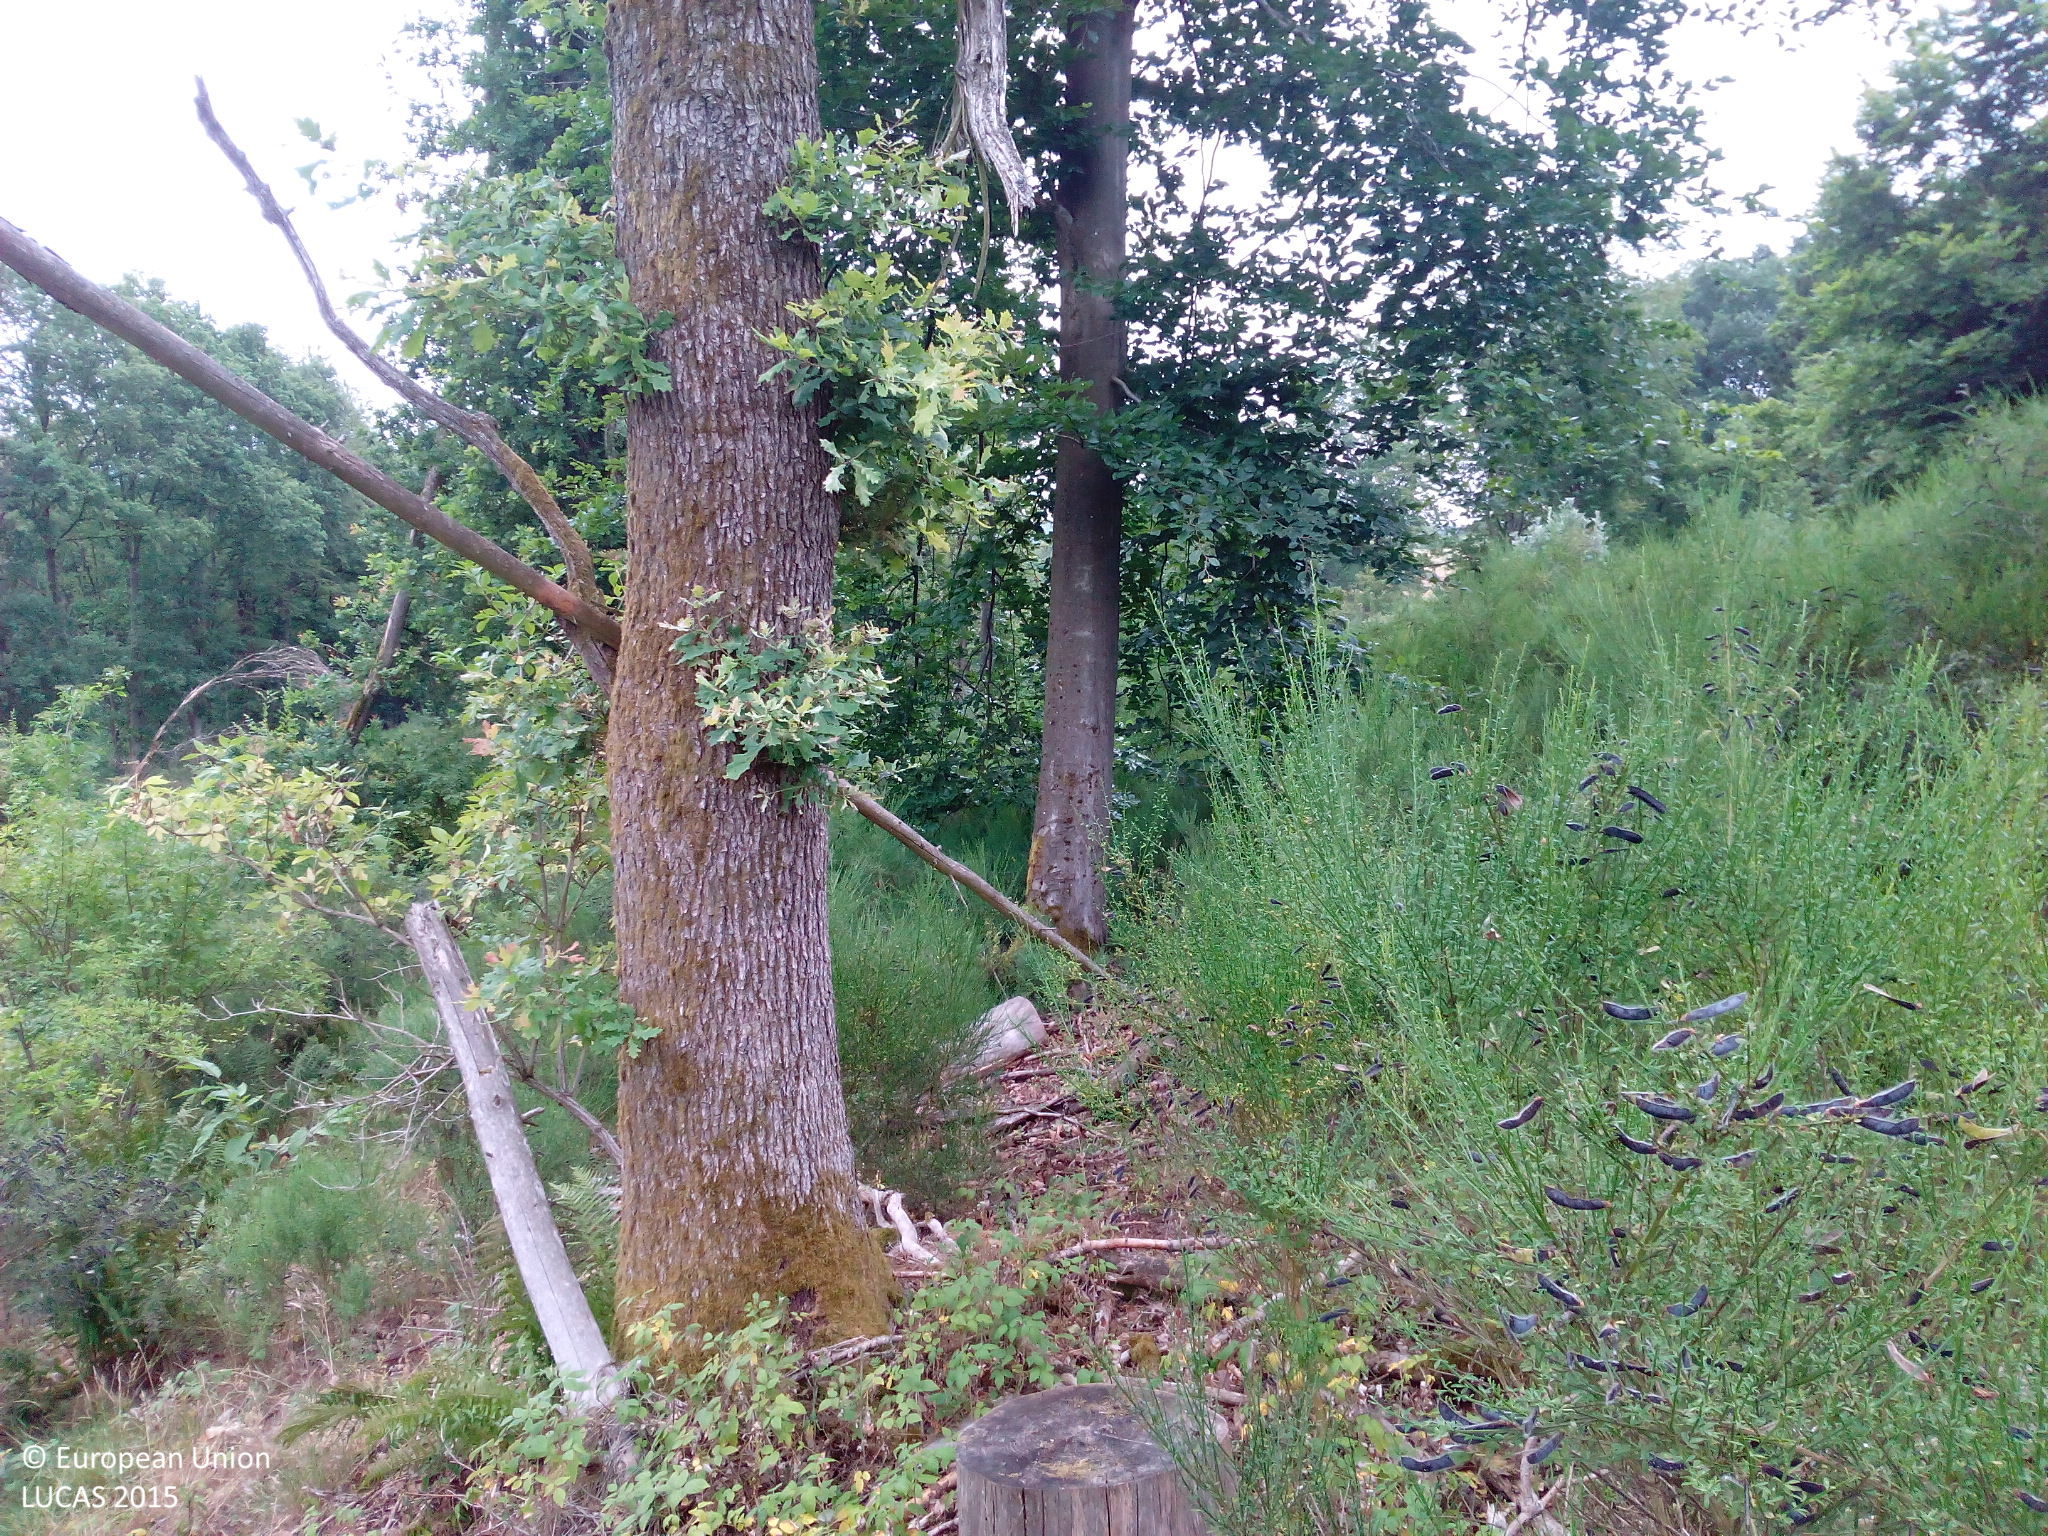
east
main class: Woodland
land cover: Broadleaved woodland
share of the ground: > 75 %
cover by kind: broadleaved forest trees 85 %, shrubs 10 %, herbaceous plants 5 %
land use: Forestry
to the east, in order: Broadleaved woodland; Grassland without tree/shrub cover; Fences; Broadleaved woodland; Grassland without tree/shrub cover; Fences; Grassland without tree/shrub cover
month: July
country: DE
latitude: 49.5006
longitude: 7.1420
